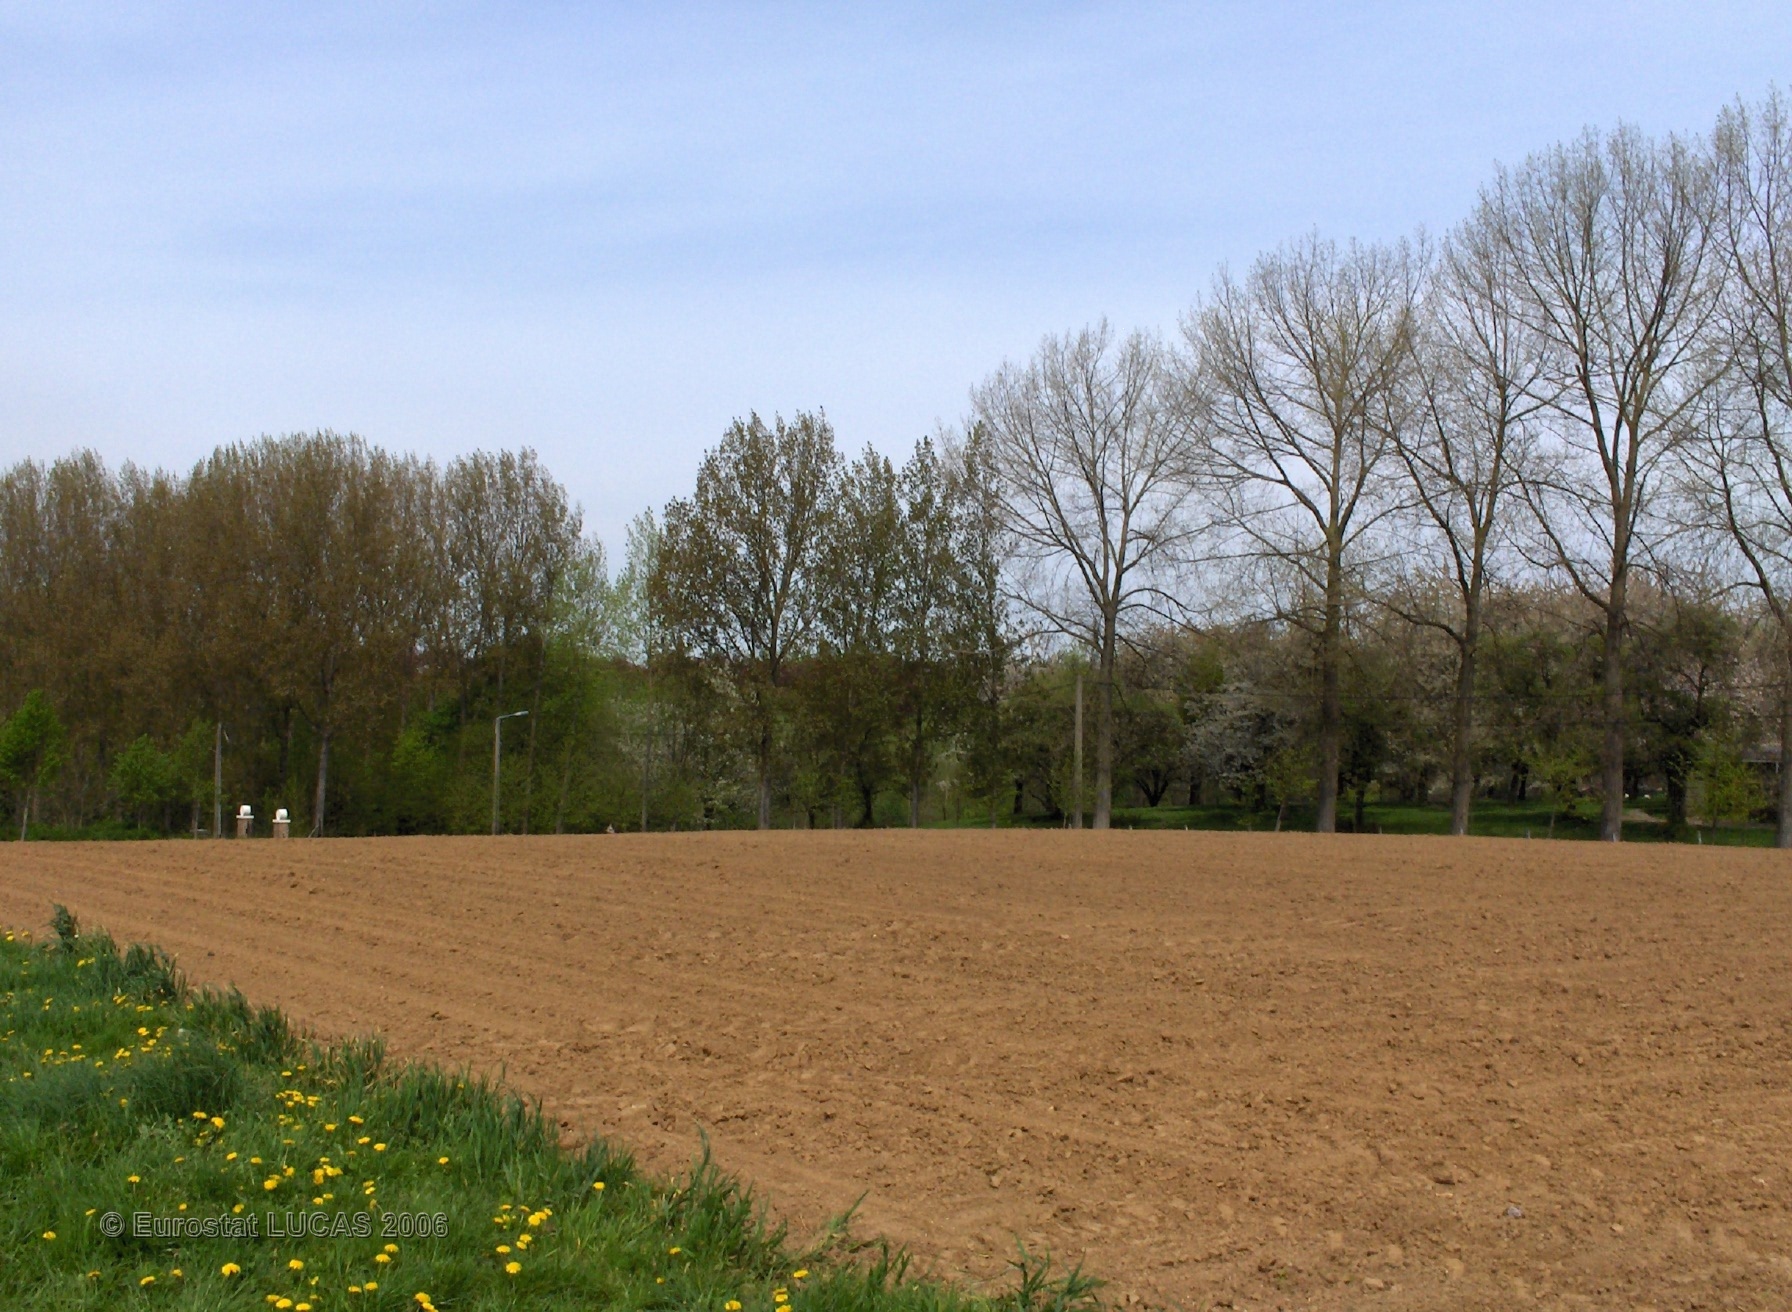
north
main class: Cropland
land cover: Other fibre and oleaginous crops
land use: Agriculture (excluding fallow land and kitchen gardens)
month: May
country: BE
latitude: 50.7338
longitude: 5.2512
